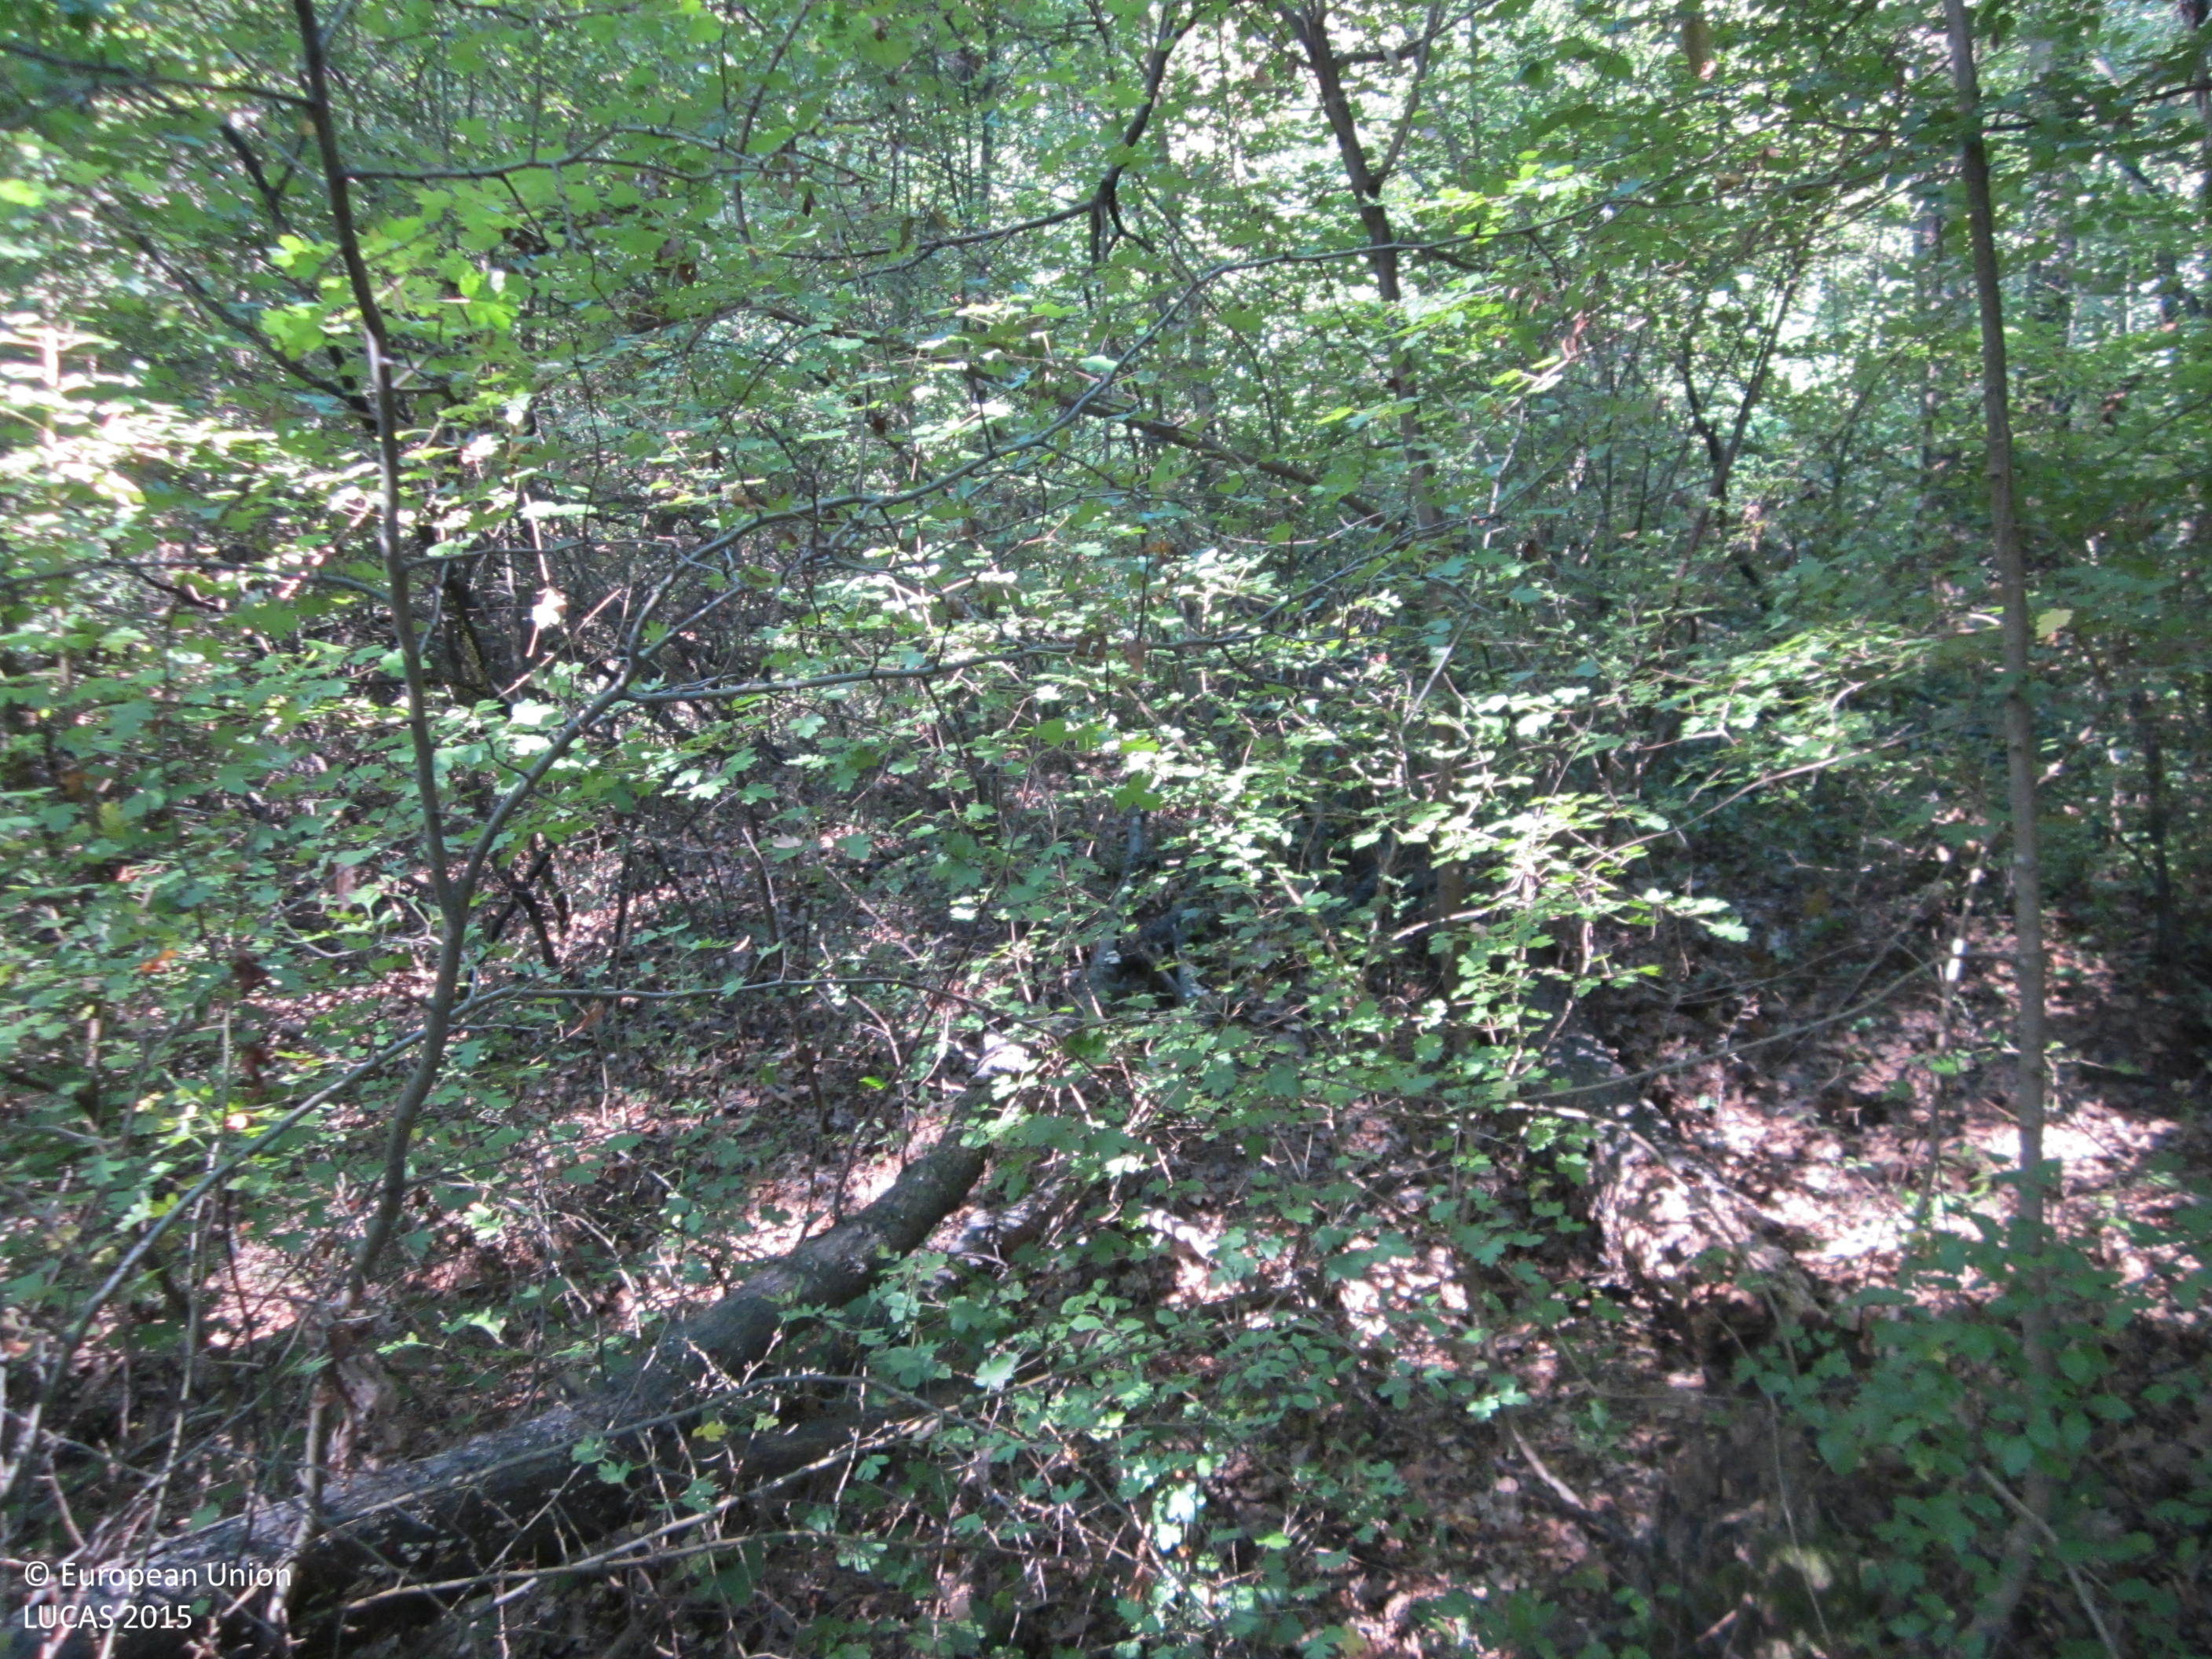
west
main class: Woodland
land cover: Broadleaved woodland
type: mesophytic deciduous forest
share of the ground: > 75 %
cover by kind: broadleaved forest trees 95 %, unconsolidated bare surface 5 %
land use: Forestry
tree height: > 5 m
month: September
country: BG
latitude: 42.8407
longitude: 26.9056
